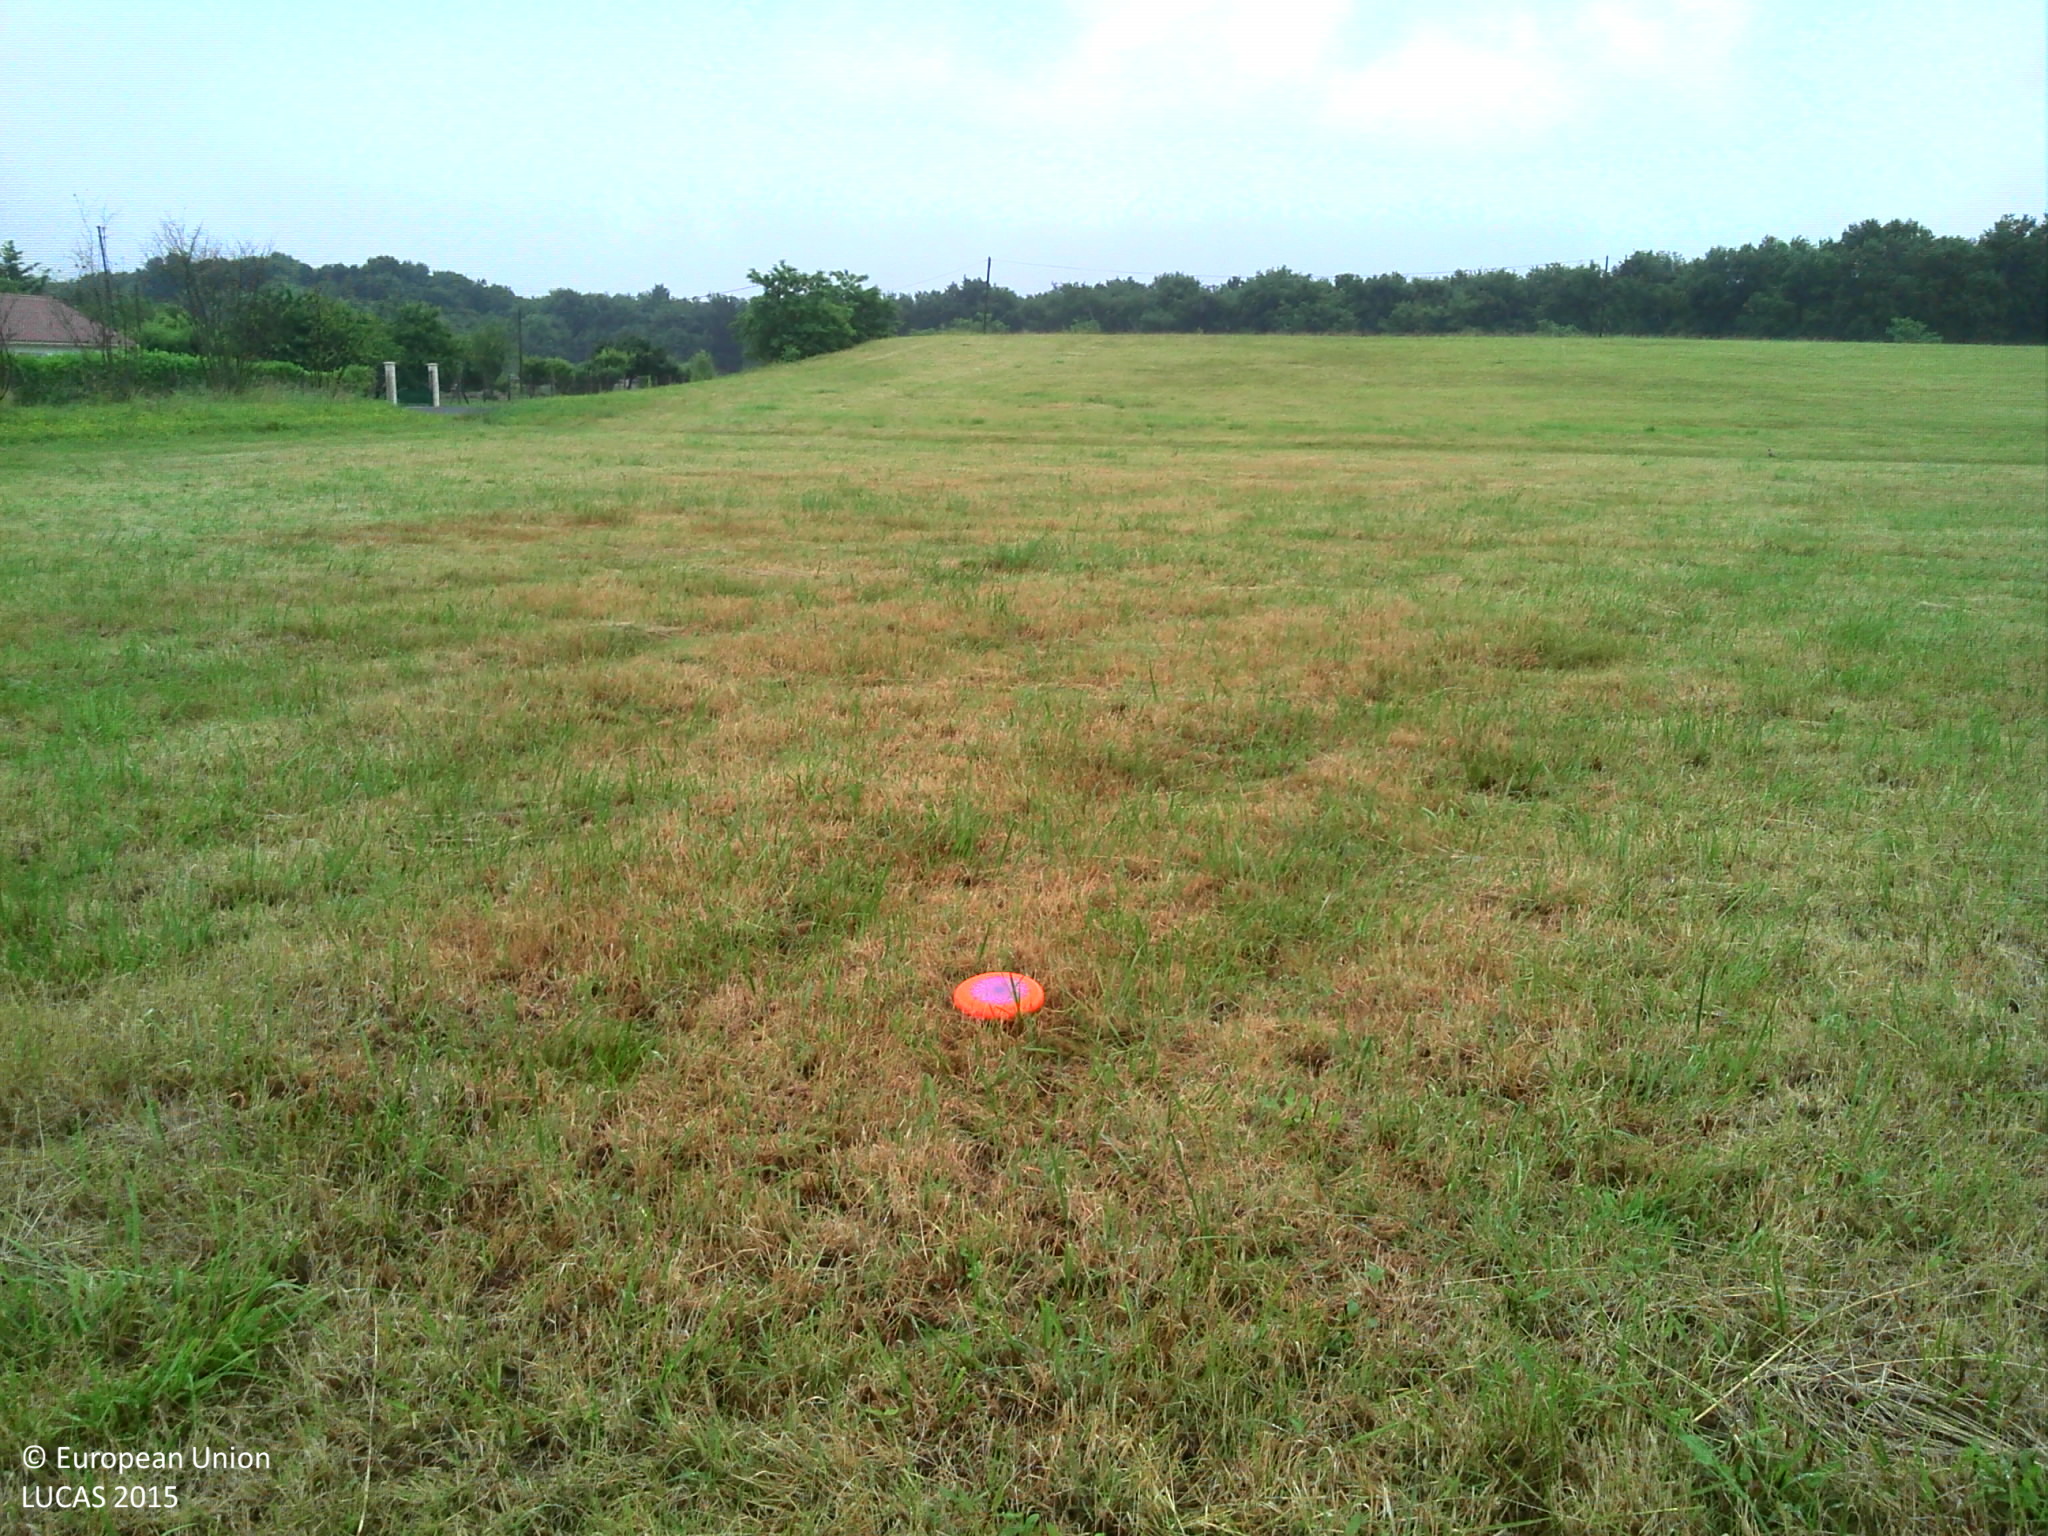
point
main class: Grassland
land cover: Grassland without tree/shrub cover
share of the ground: > 75 %
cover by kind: herbaceous plants 100 %
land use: Agriculture (excluding fallow land and kitchen gardens)
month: June
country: FR
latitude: 46.5433
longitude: 0.2915
